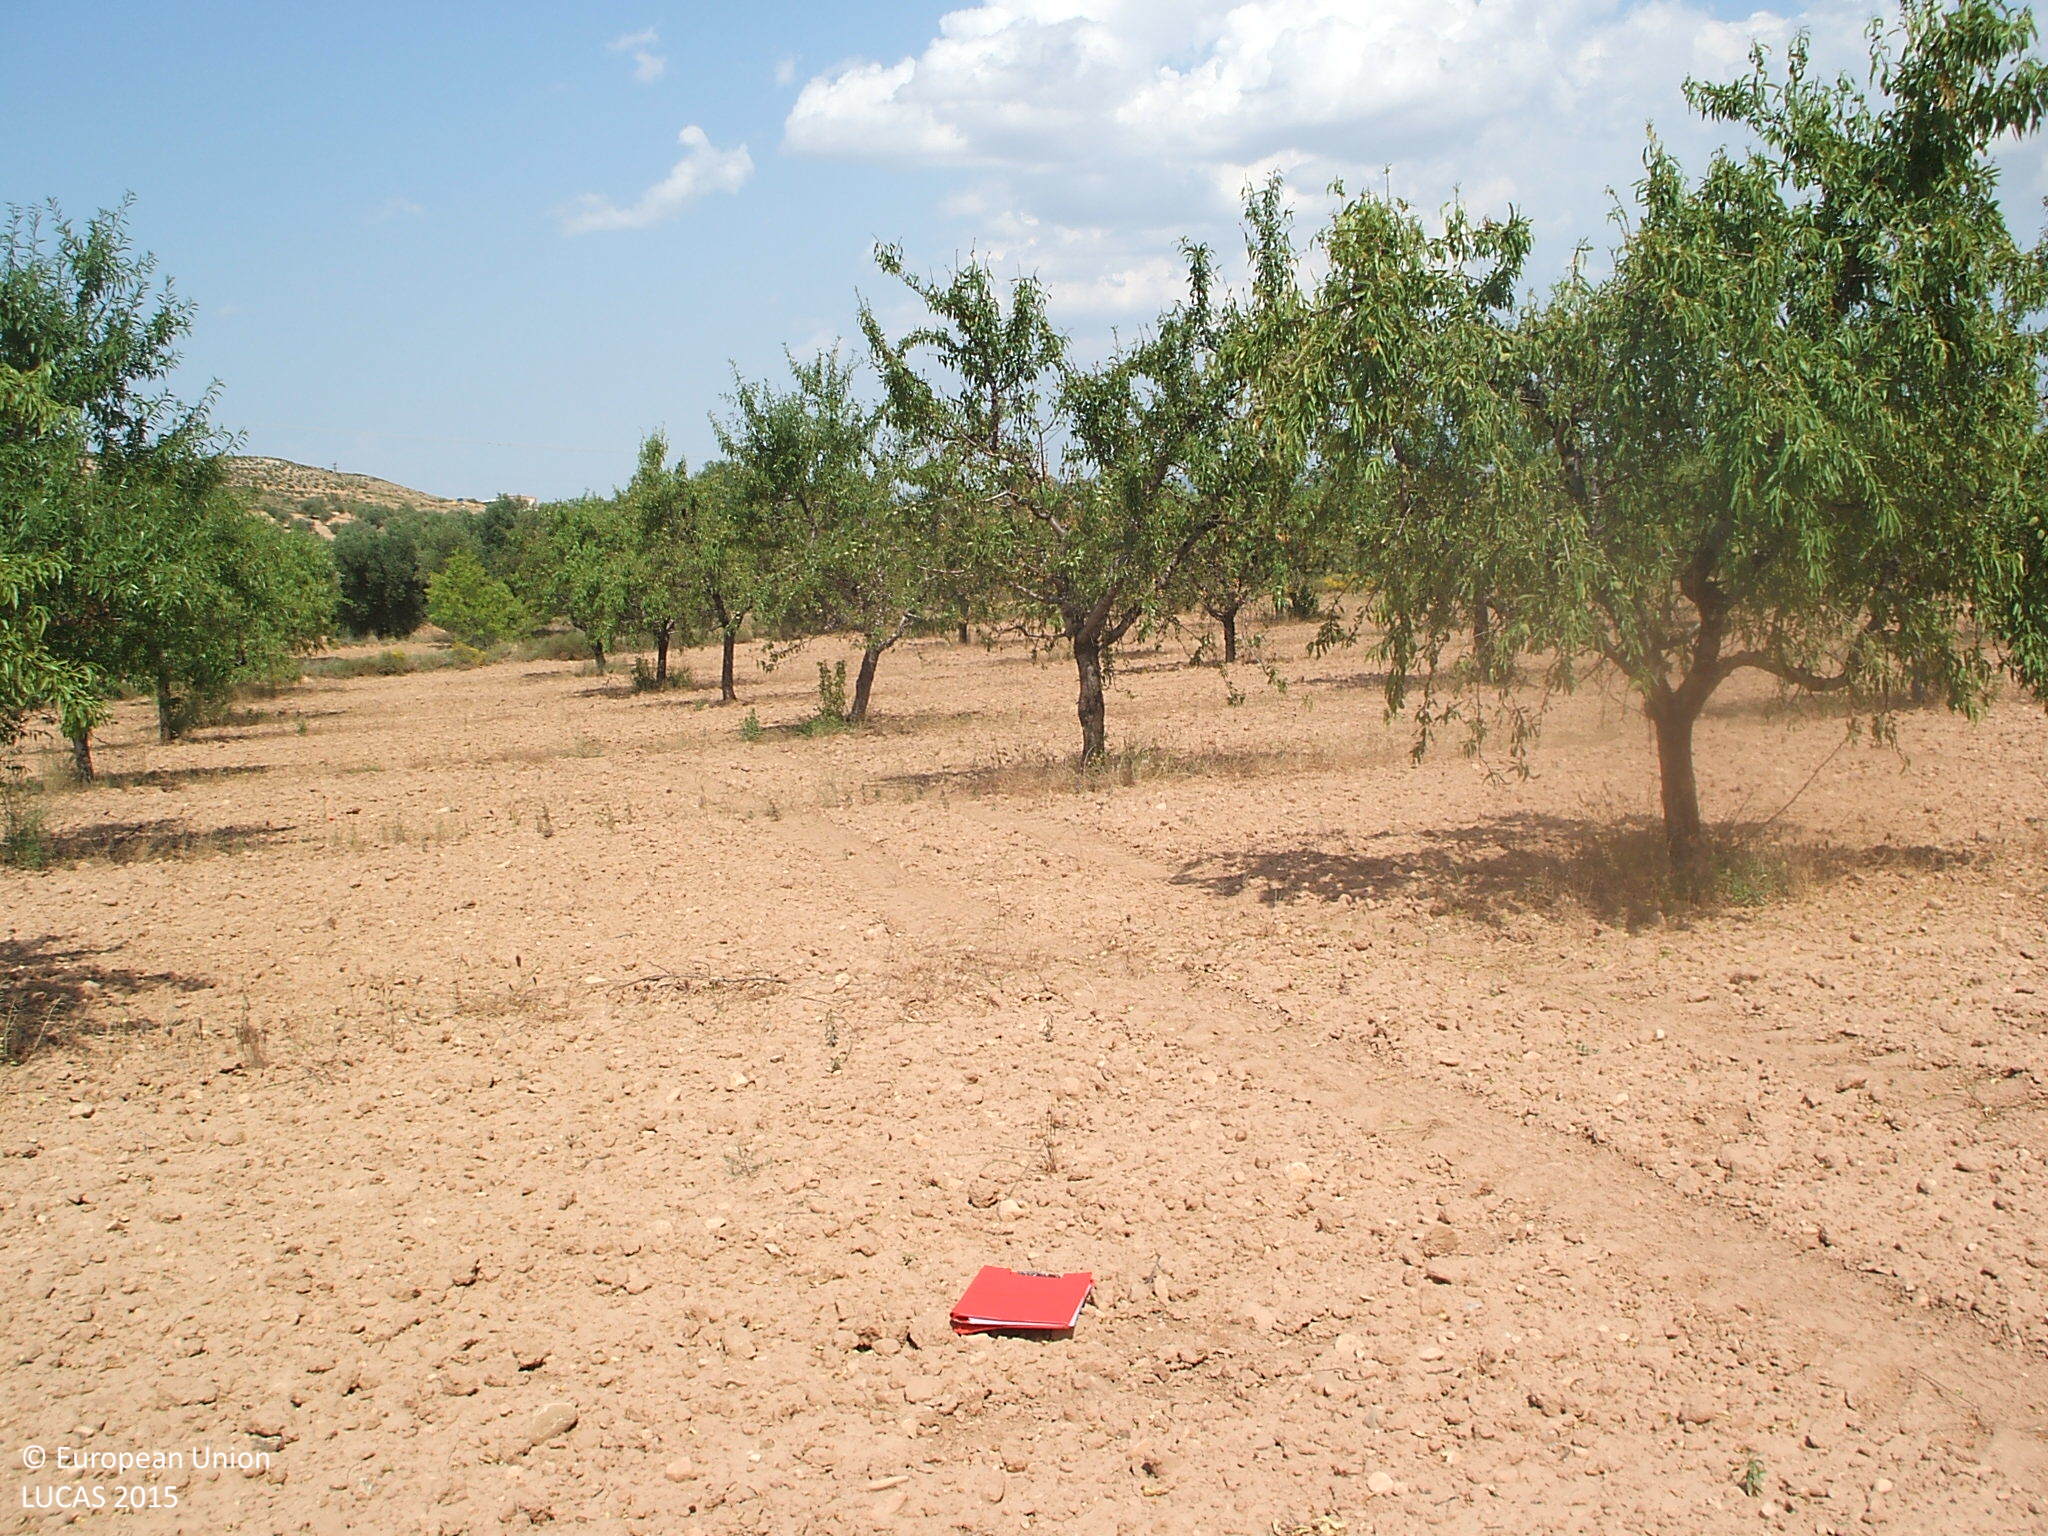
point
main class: Cropland
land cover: Nuts trees
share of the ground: 25 - 50 %
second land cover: Other bare soil
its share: > 75 %
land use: Agriculture (excluding fallow land and kitchen gardens)
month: June
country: ES
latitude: 40.9662
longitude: -0.2659
